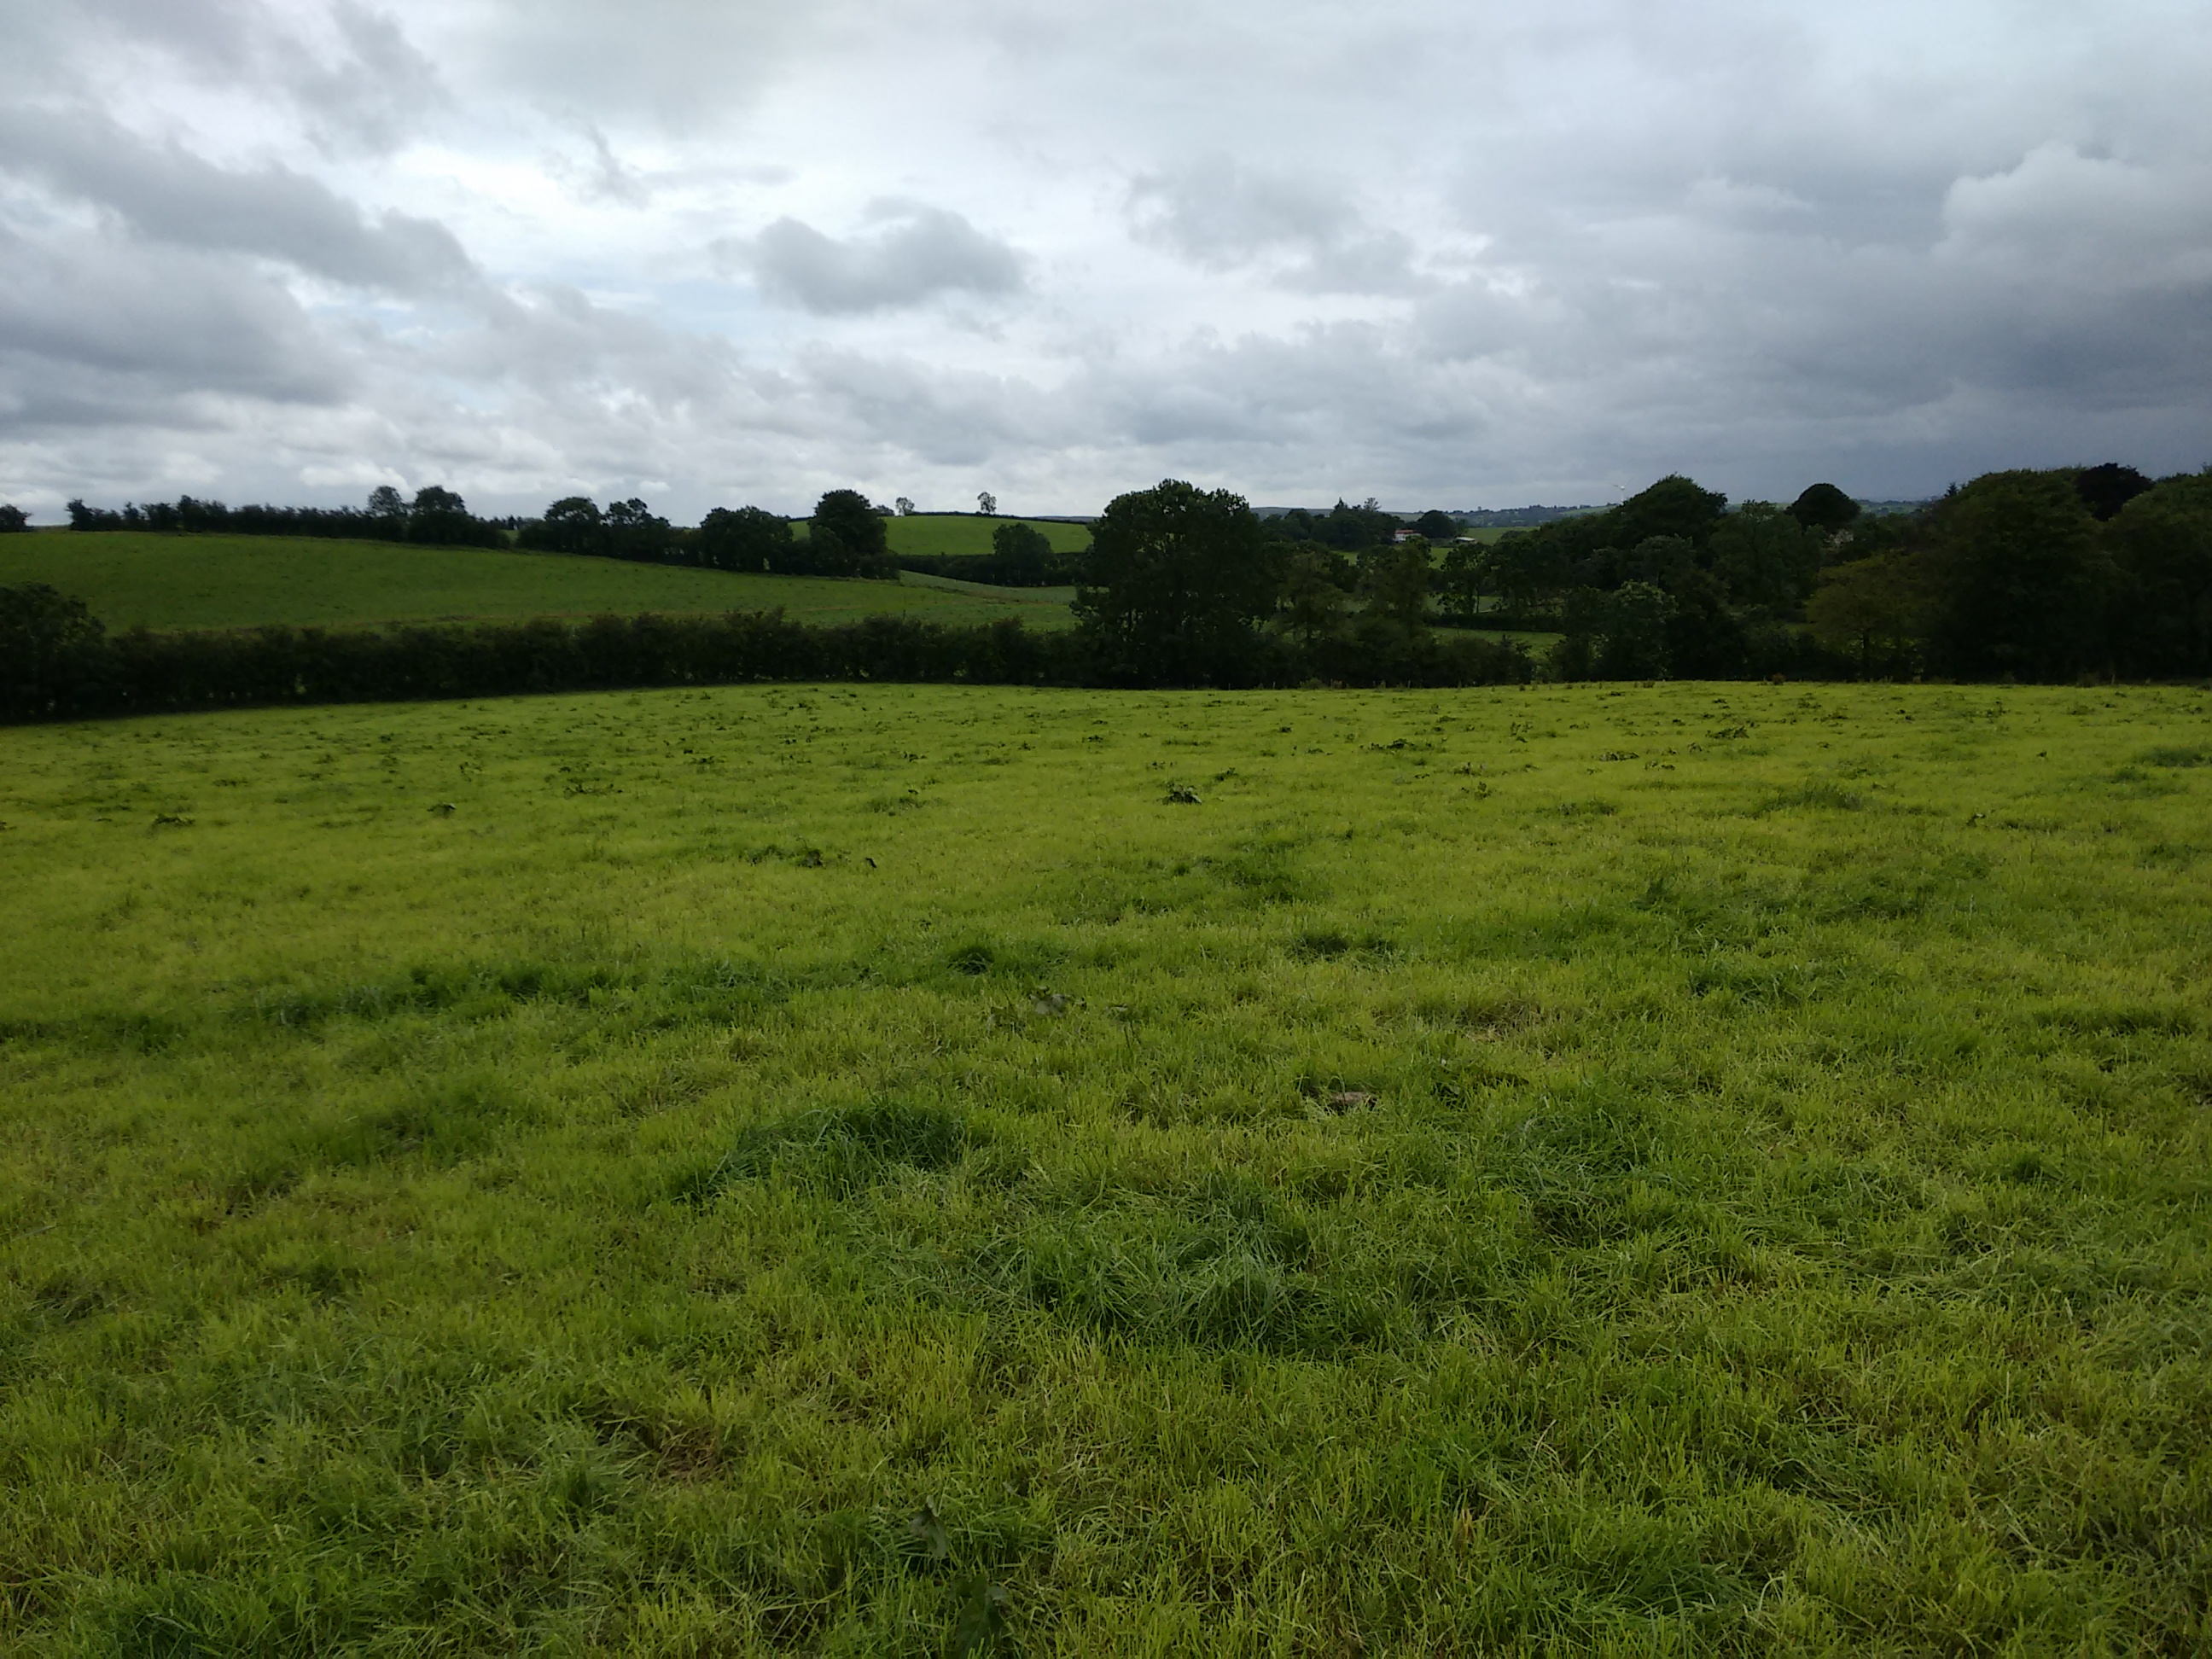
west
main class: Grassland
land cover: Grassland without tree/shrub cover
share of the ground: > 75 %
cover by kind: herbaceous plants 100 %
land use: Agriculture (excluding fallow land and kitchen gardens)
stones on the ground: < 10 %
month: July
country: GB
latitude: 54.4916
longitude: -7.3649
